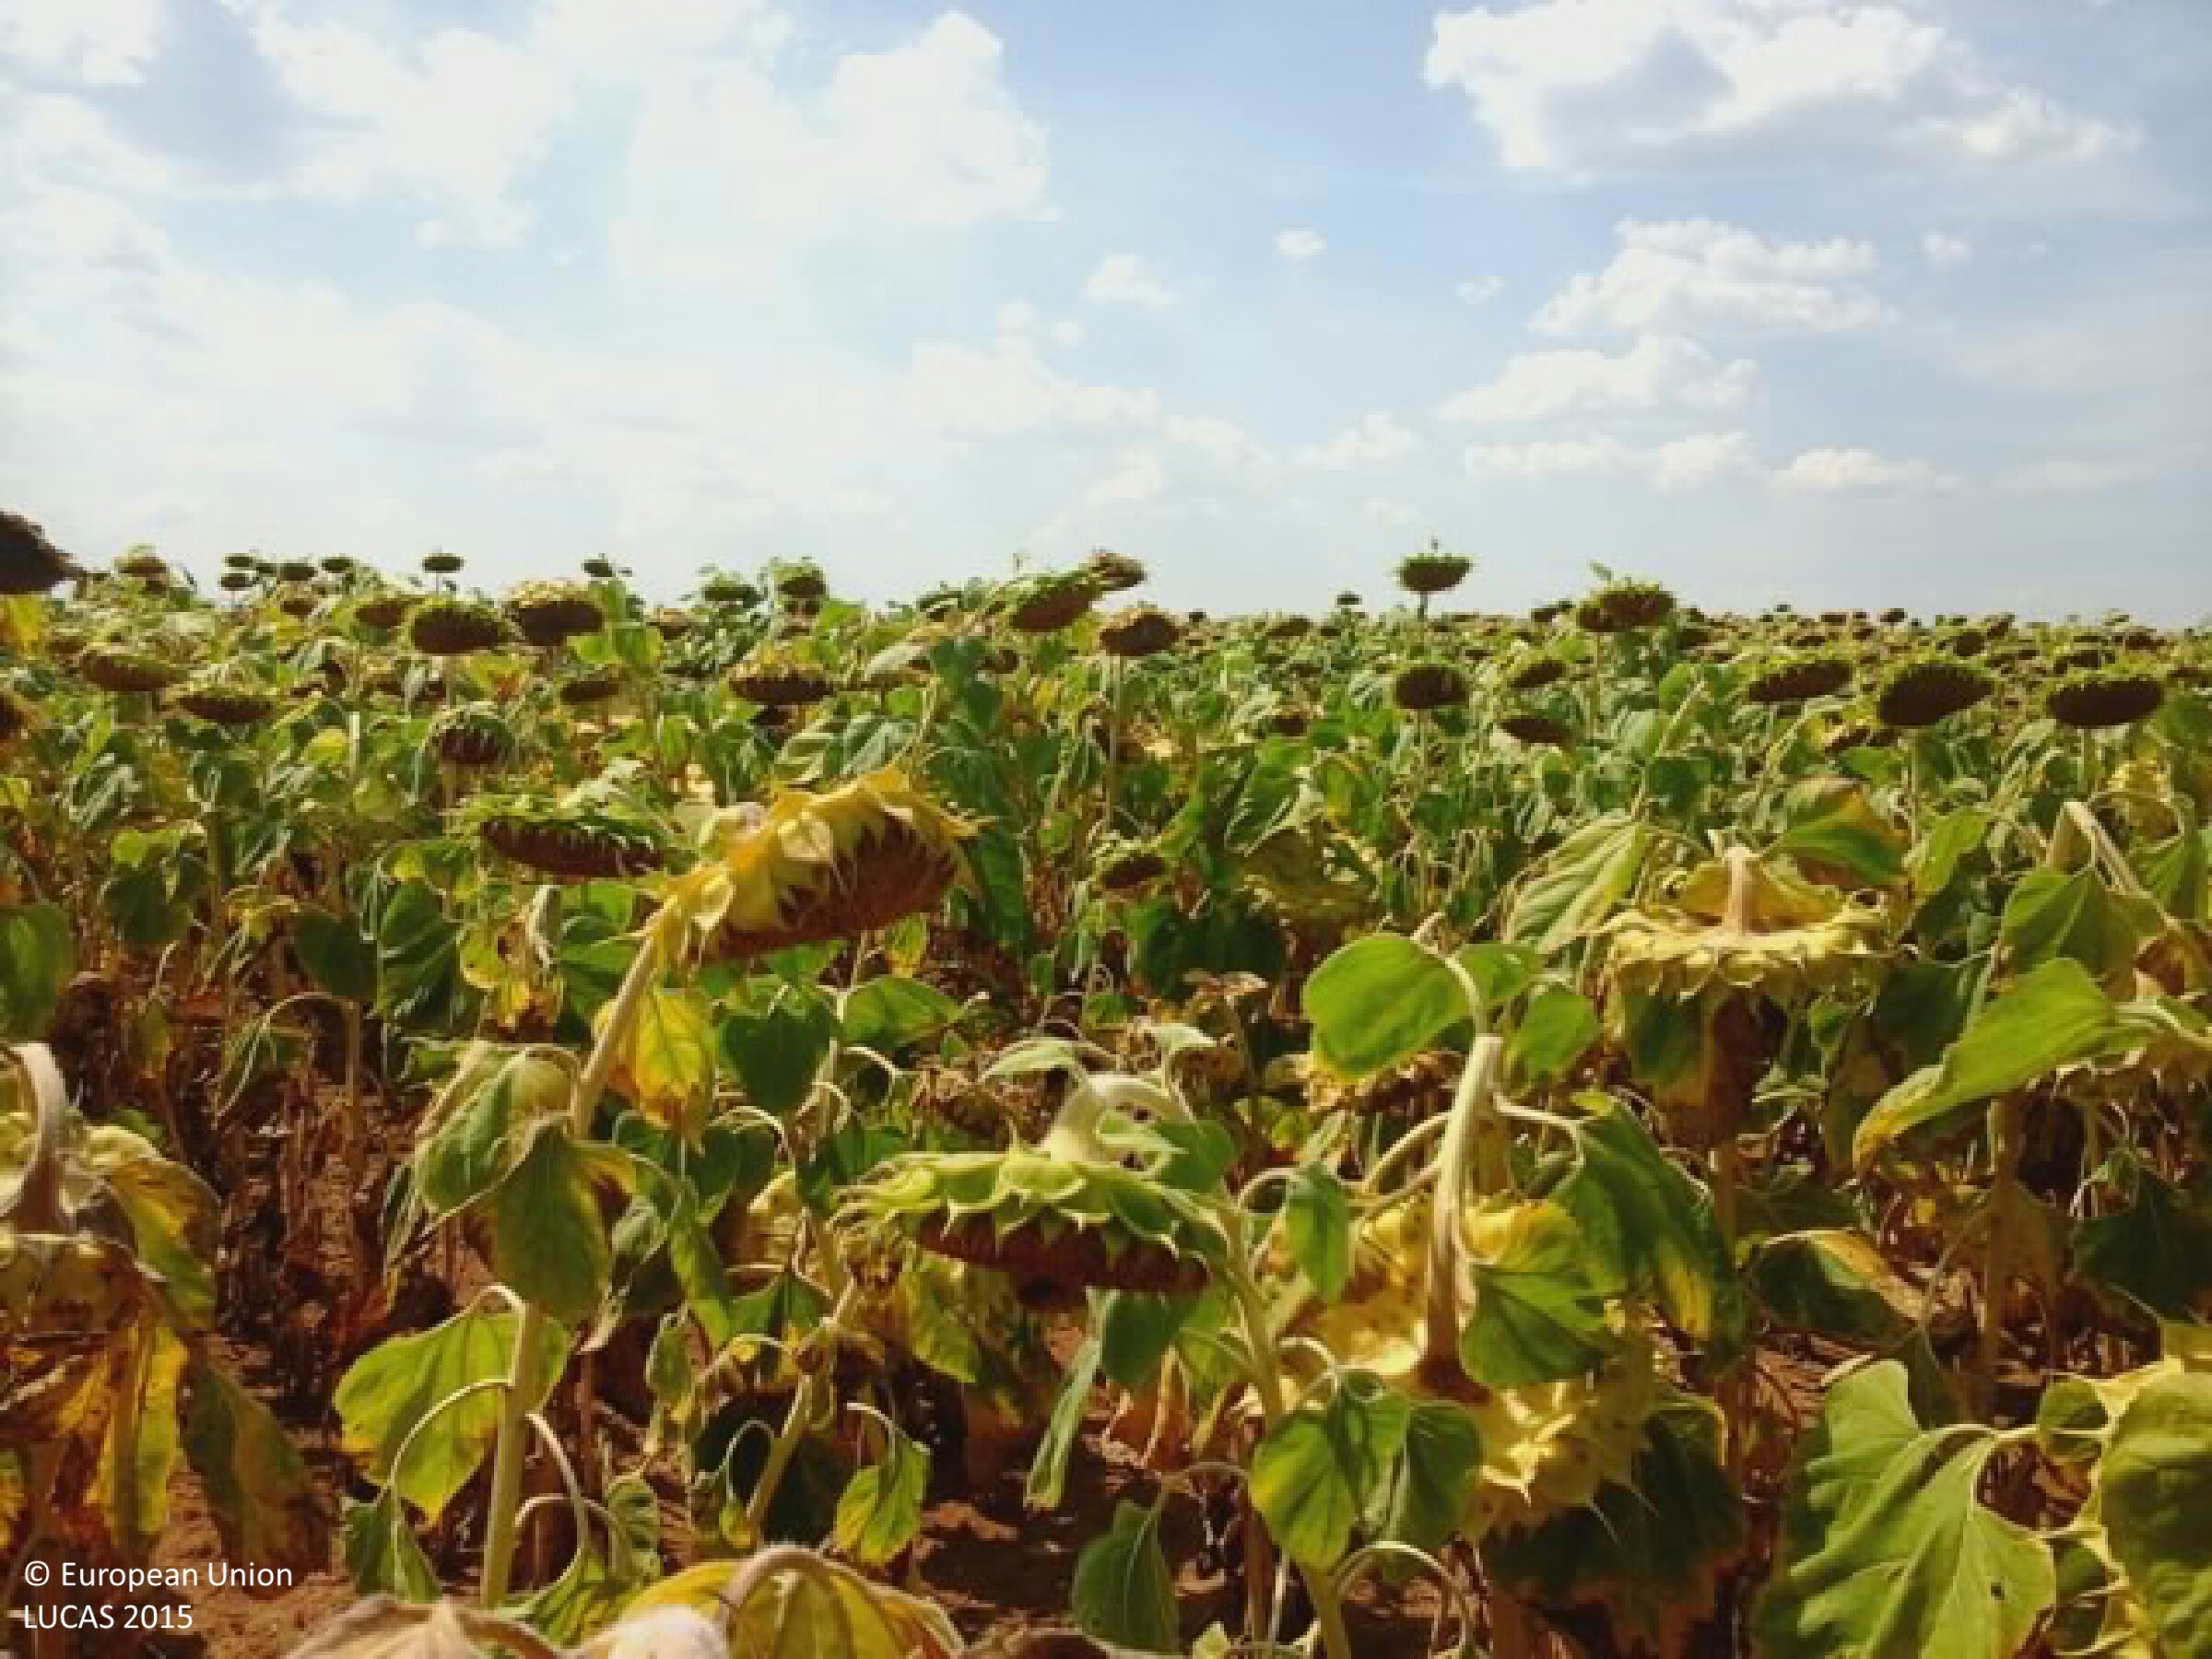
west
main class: Cropland
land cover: Sunflower
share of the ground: > 75 %
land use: Agriculture (excluding fallow land and kitchen gardens)
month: August
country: HU
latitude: 46.5518
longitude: 18.0814
